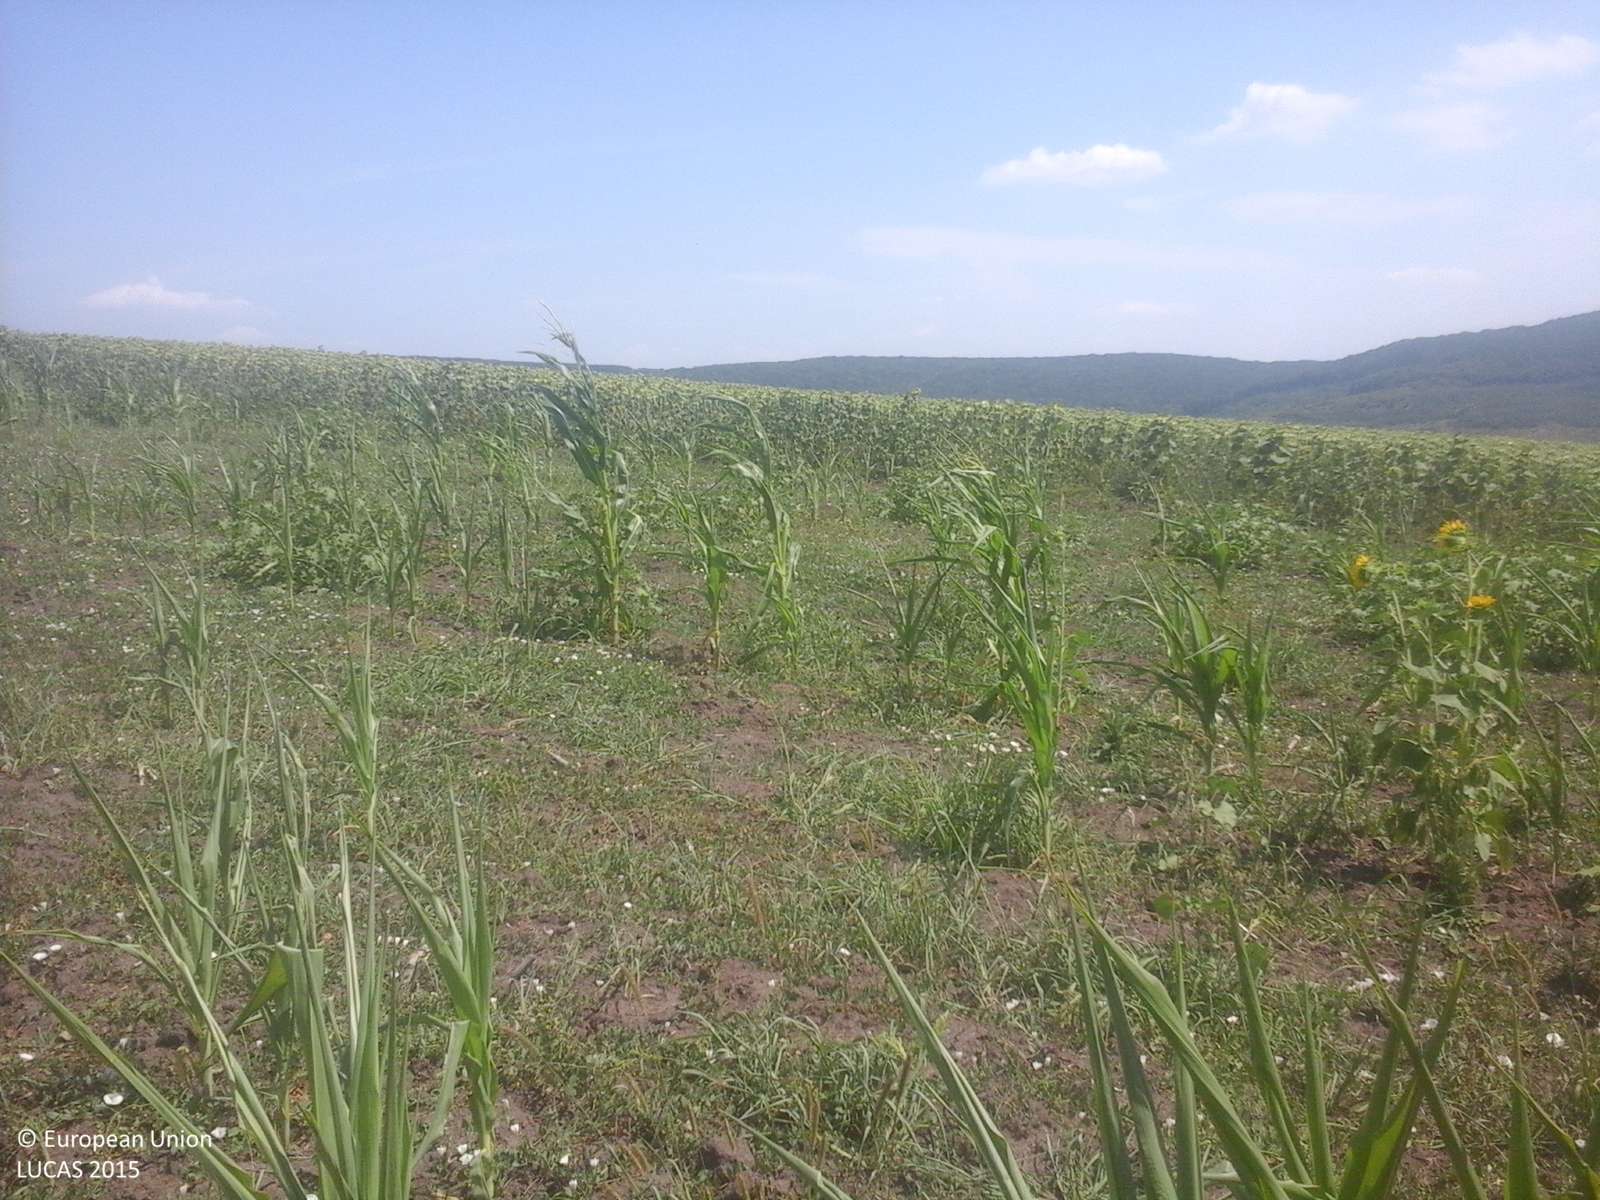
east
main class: Cropland
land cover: Maize
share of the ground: 50 - 75 %
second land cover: Spontaneously vegetated surfaces
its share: 25 - 50 %
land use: Agriculture (excluding fallow land and kitchen gardens)
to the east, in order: Maize; Spontaneously vegetated surfaces; Sunflower; Lucerne
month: July
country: RO
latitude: 46.6575
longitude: 27.9644
